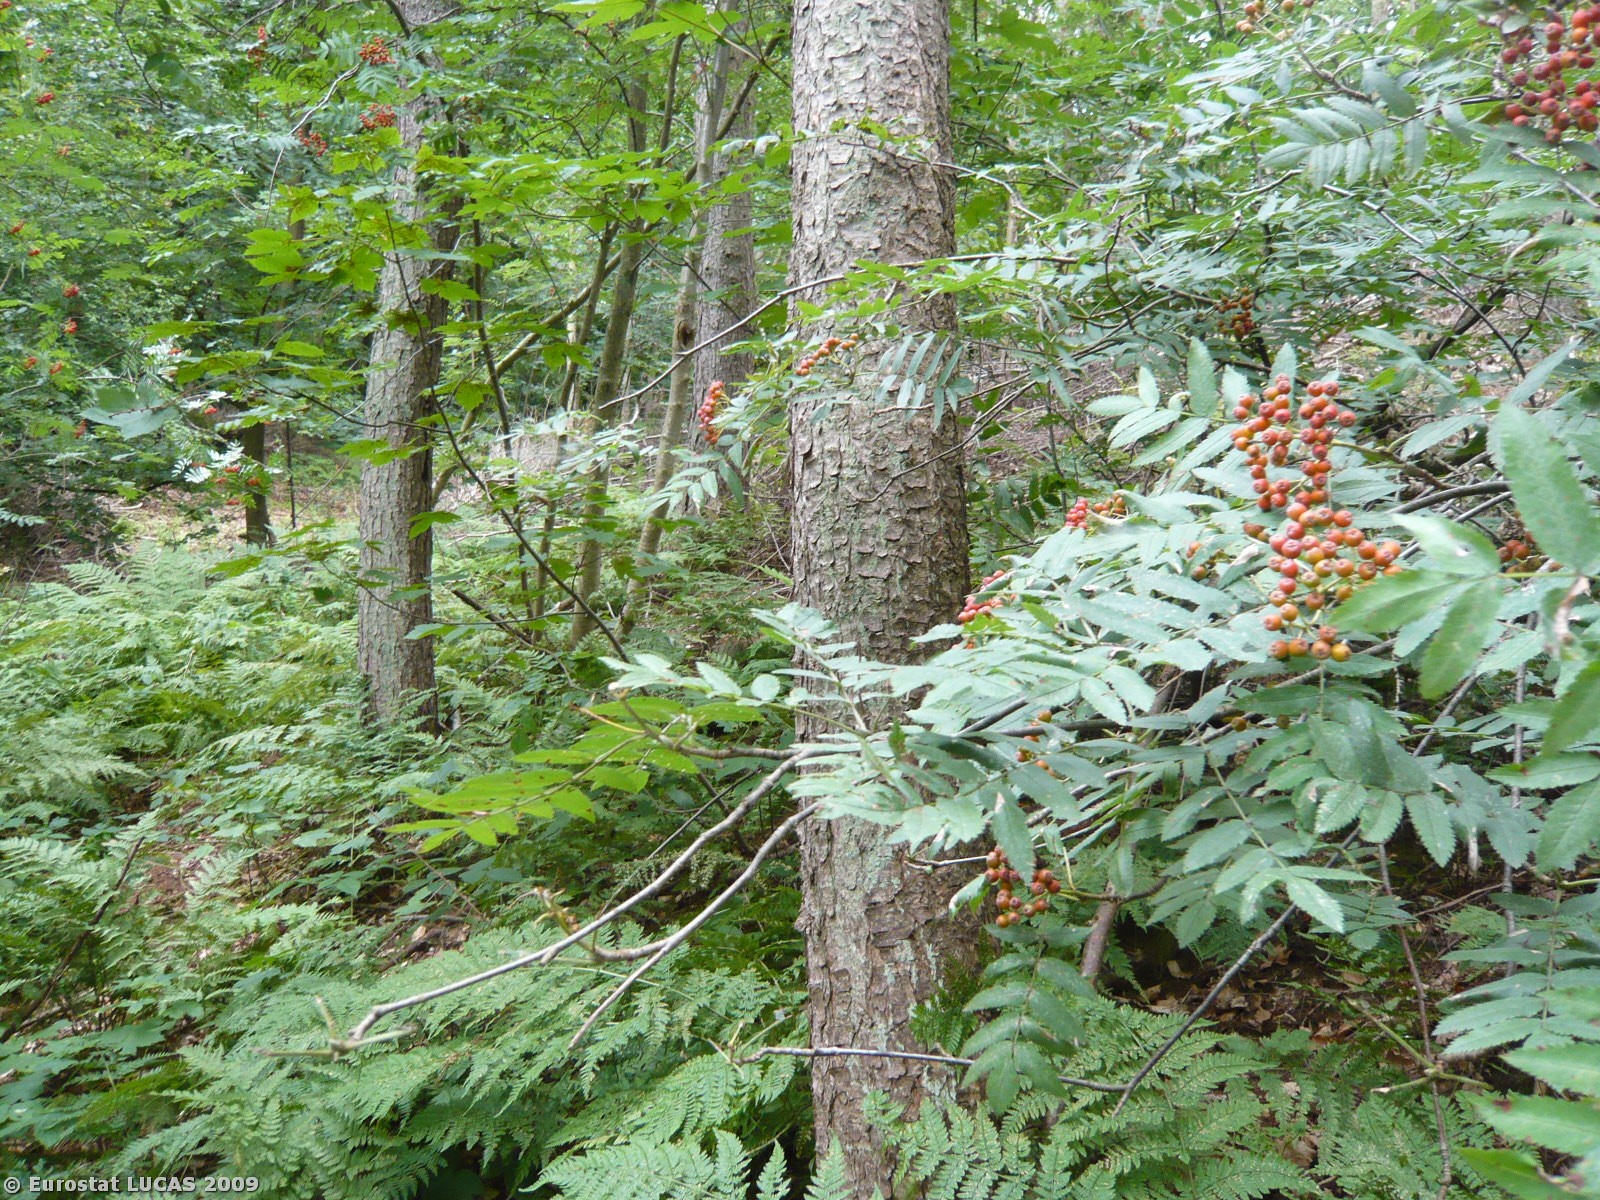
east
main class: Woodland
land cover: Coniferous woodland
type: hemiboreal forest and nemoral coniferous forest and mixed broadleaved-coniferous forest
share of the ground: > 75 %
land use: Amenities, museums, leisure
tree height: > 5 m
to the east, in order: Coniferous woodland; Broadleaved woodland; Mixed woodland; Broadleaved woodland; Tracks; Broadleaved woodland
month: August
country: DK
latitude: 55.9739
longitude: 12.0331
